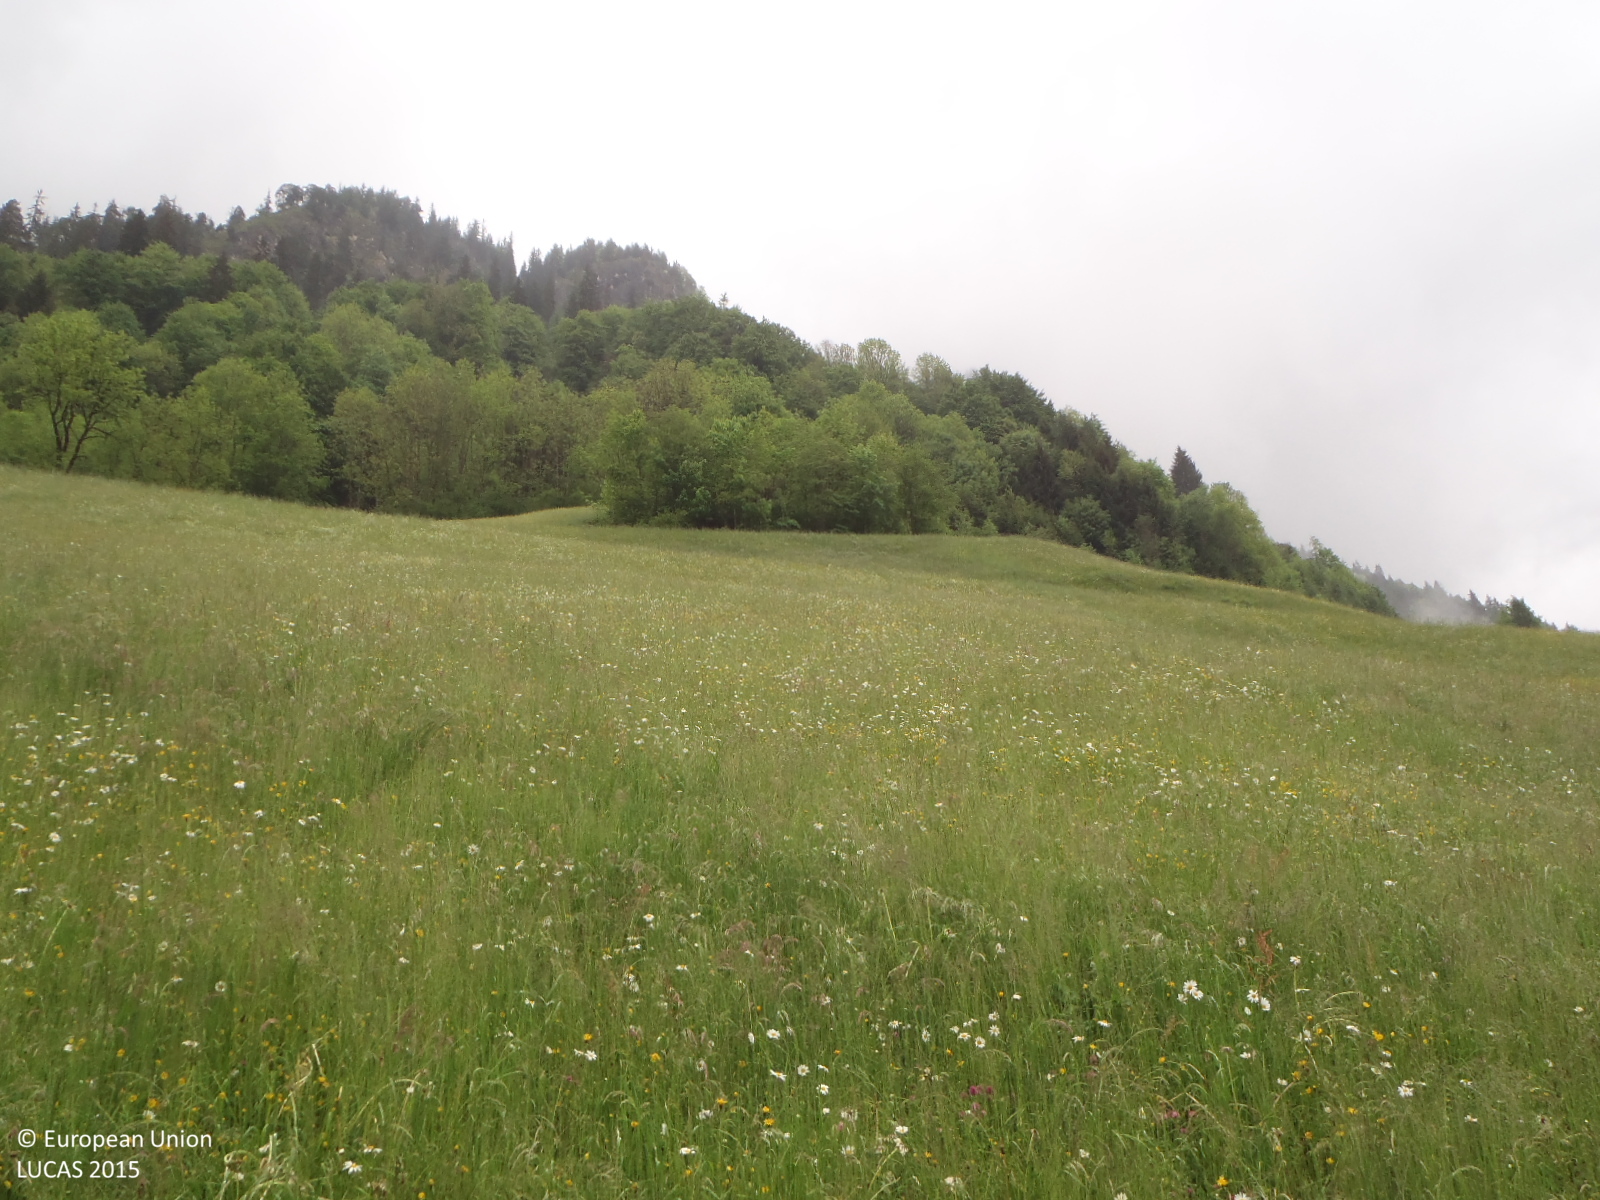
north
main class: Grassland
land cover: Grassland without tree/shrub cover
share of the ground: > 75 %
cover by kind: herbaceous plants 100 %
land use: Agriculture (excluding fallow land and kitchen gardens)
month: May
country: AT
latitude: 47.5590
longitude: 12.7494
